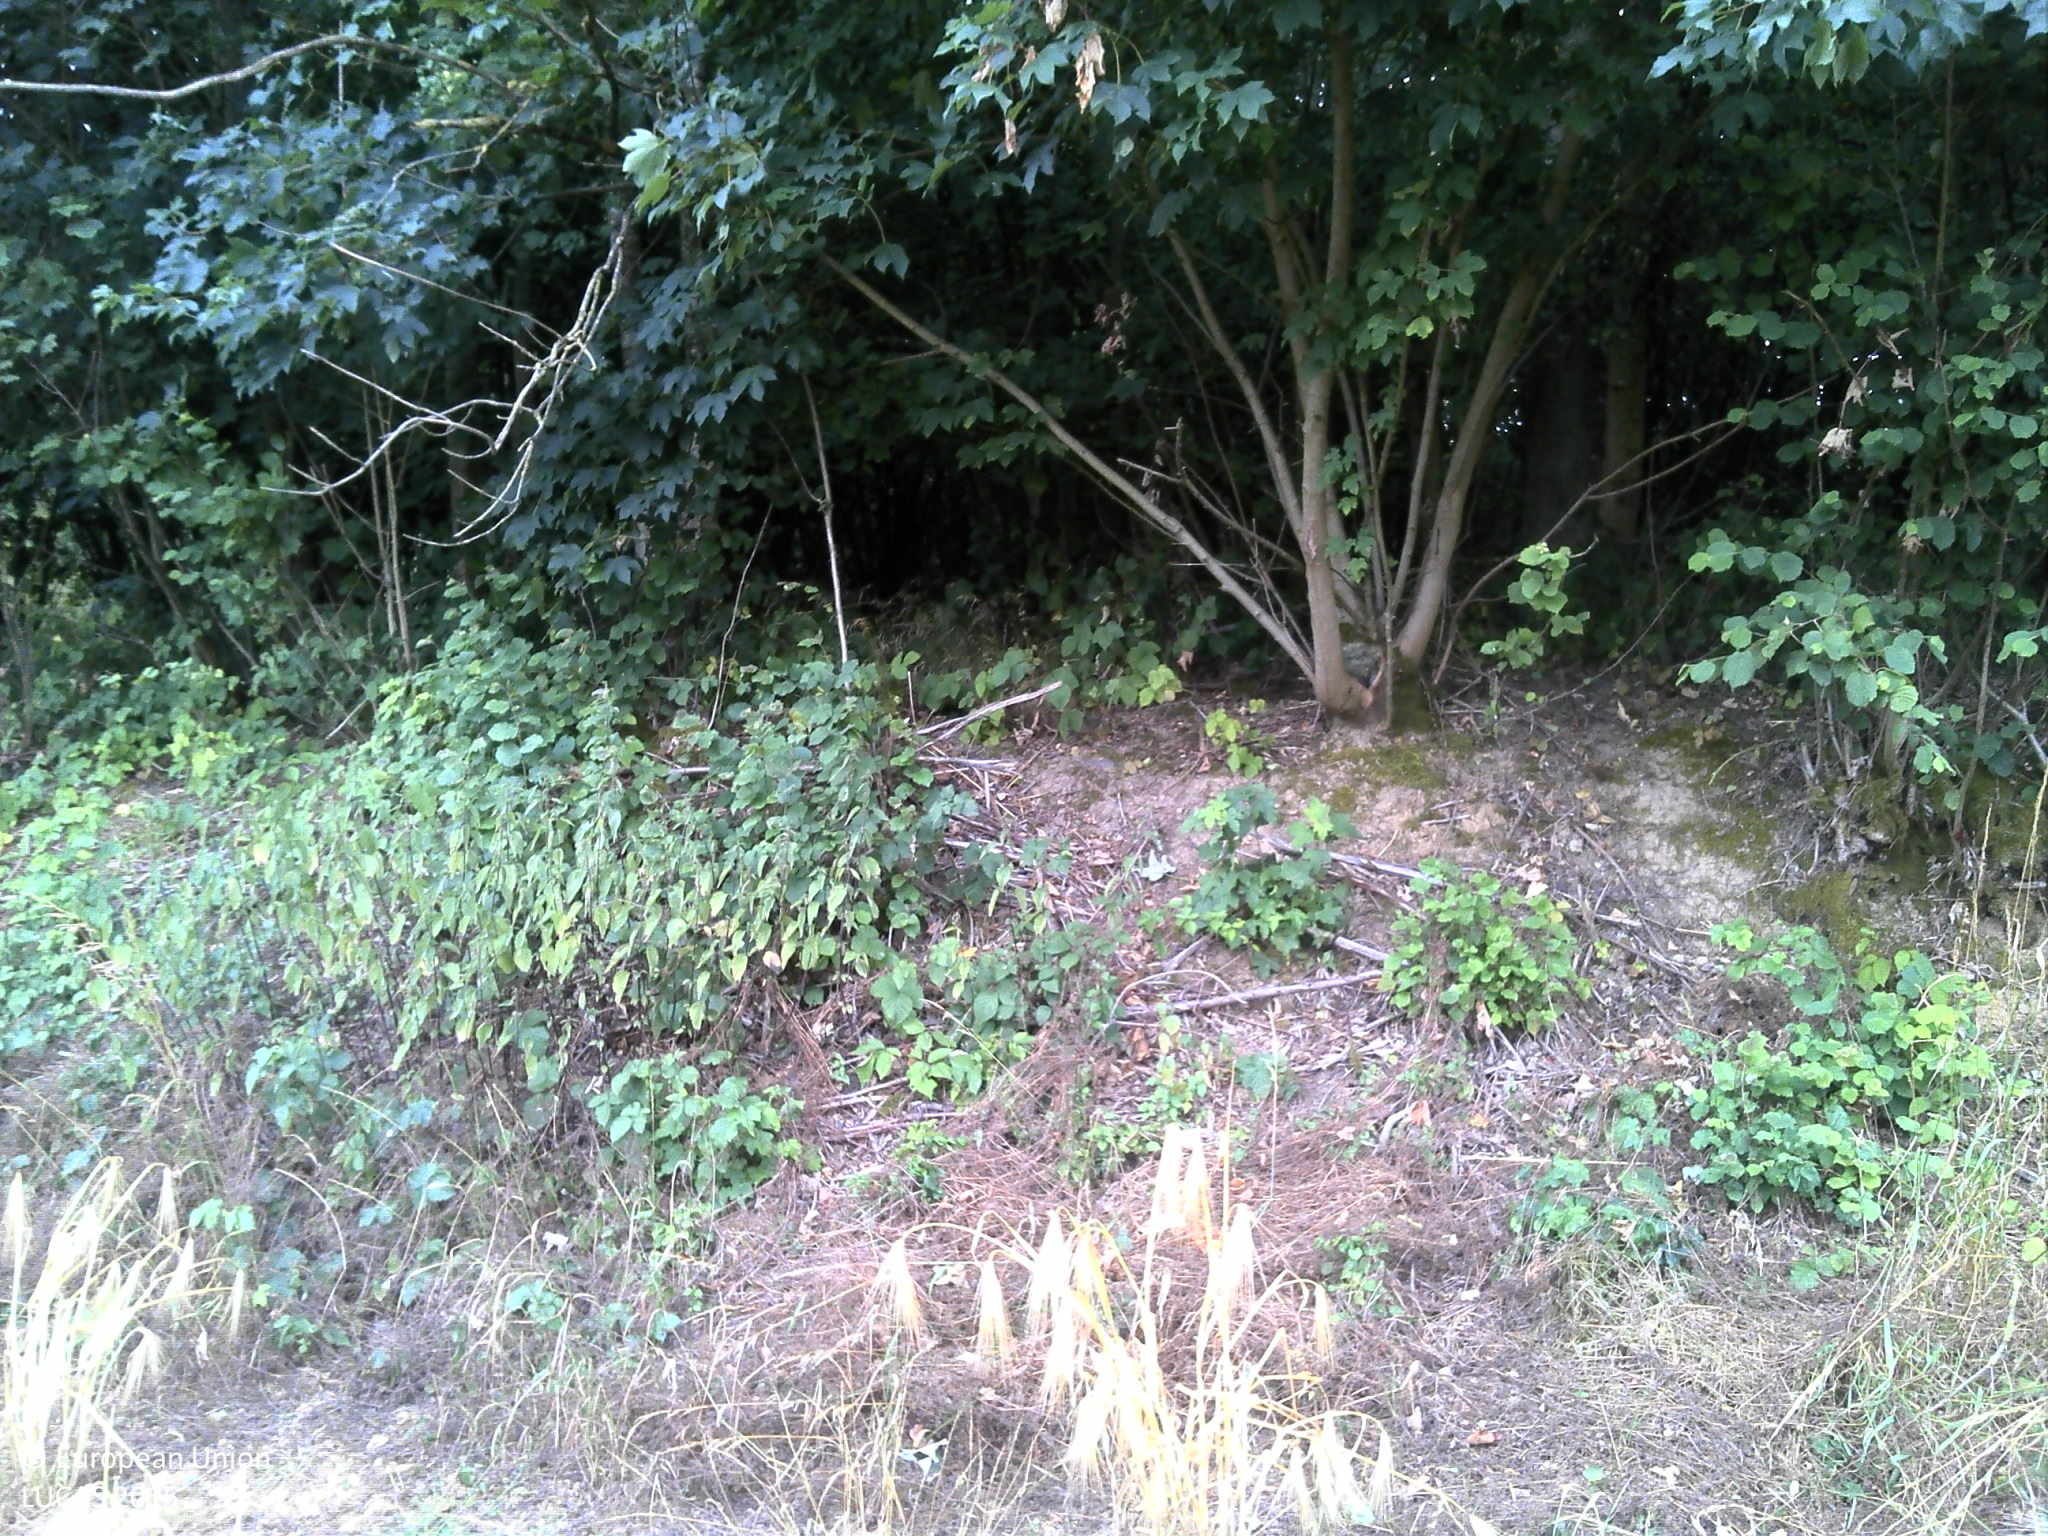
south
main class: Cropland
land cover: Rape and turnip rape
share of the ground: > 75 %
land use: Agriculture (excluding fallow land and kitchen gardens)
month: July
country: FR
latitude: 49.5472
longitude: 4.1487
